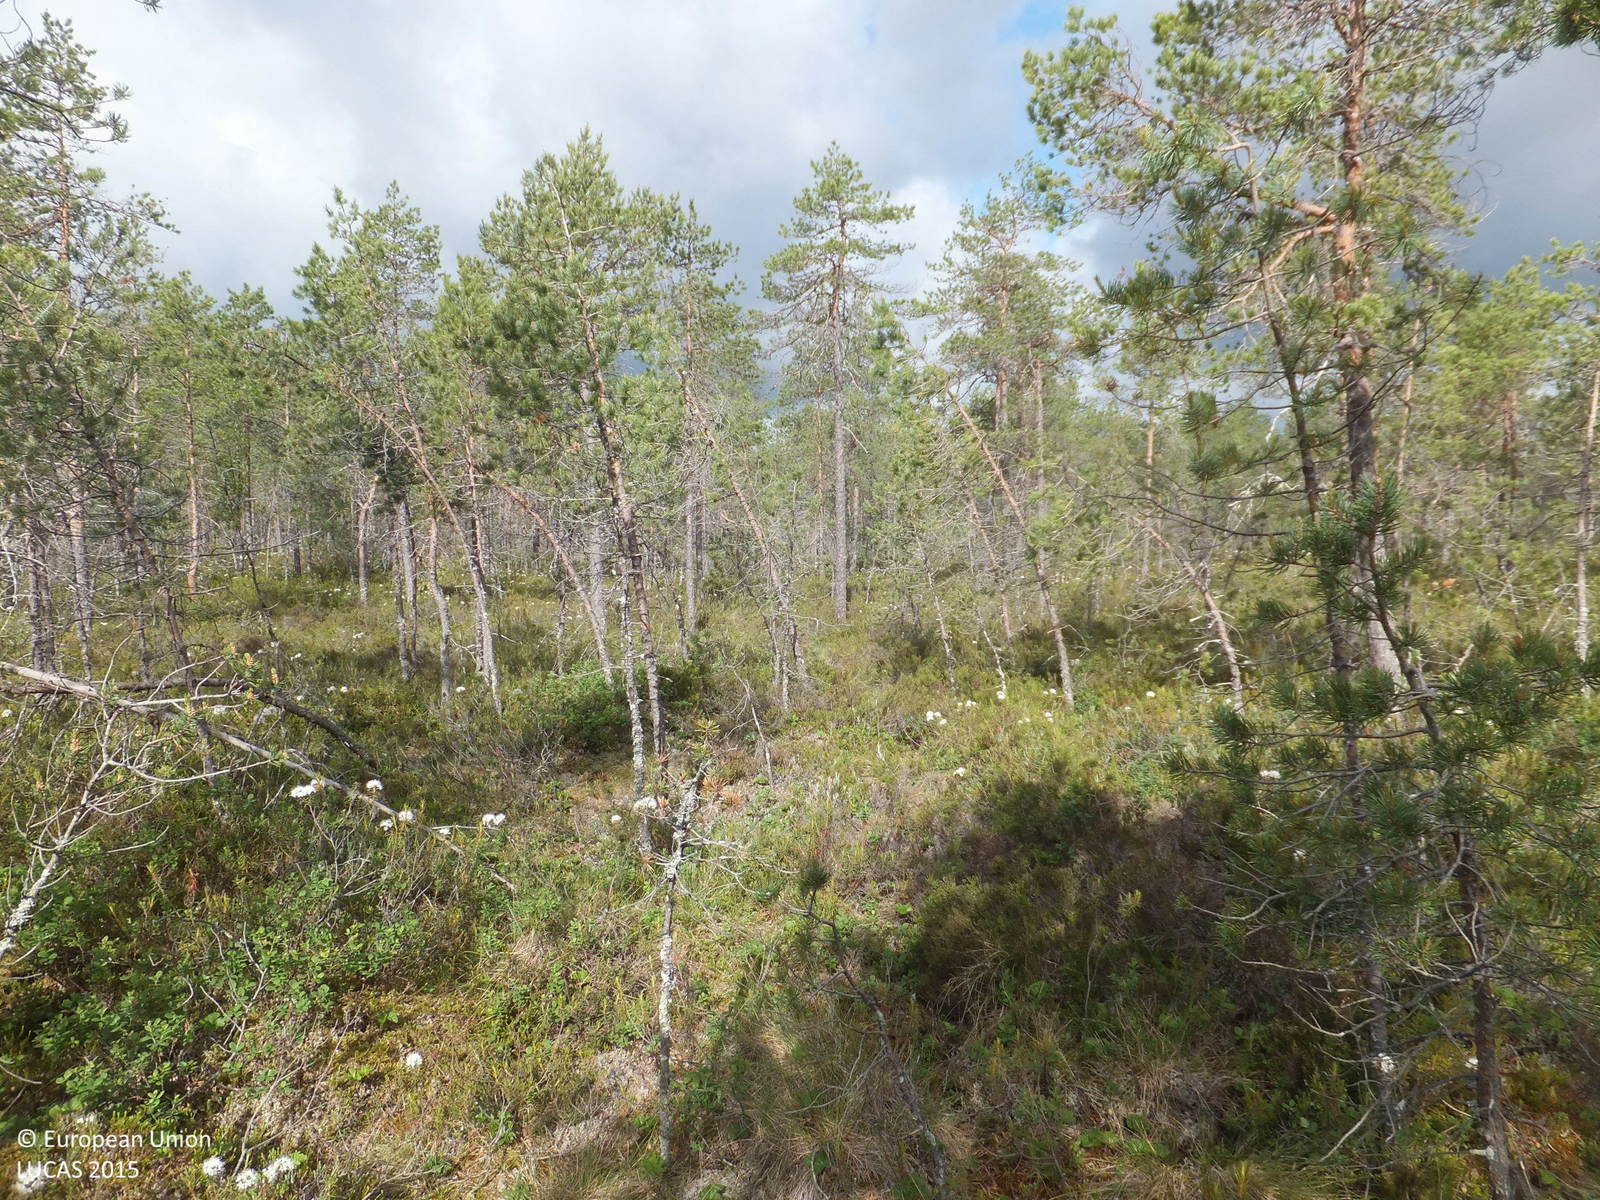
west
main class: Woodland
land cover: Pine dominated coniferous woodland
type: mire and swamp forests
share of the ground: > 75 %
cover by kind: coniferous forest trees 75 %, shrubs 10 %, herbaceous plants 10 %, lichens and mosses 5 %
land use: Forestry
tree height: < 5 m
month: June
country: FI
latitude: 63.4033
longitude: 24.0260
